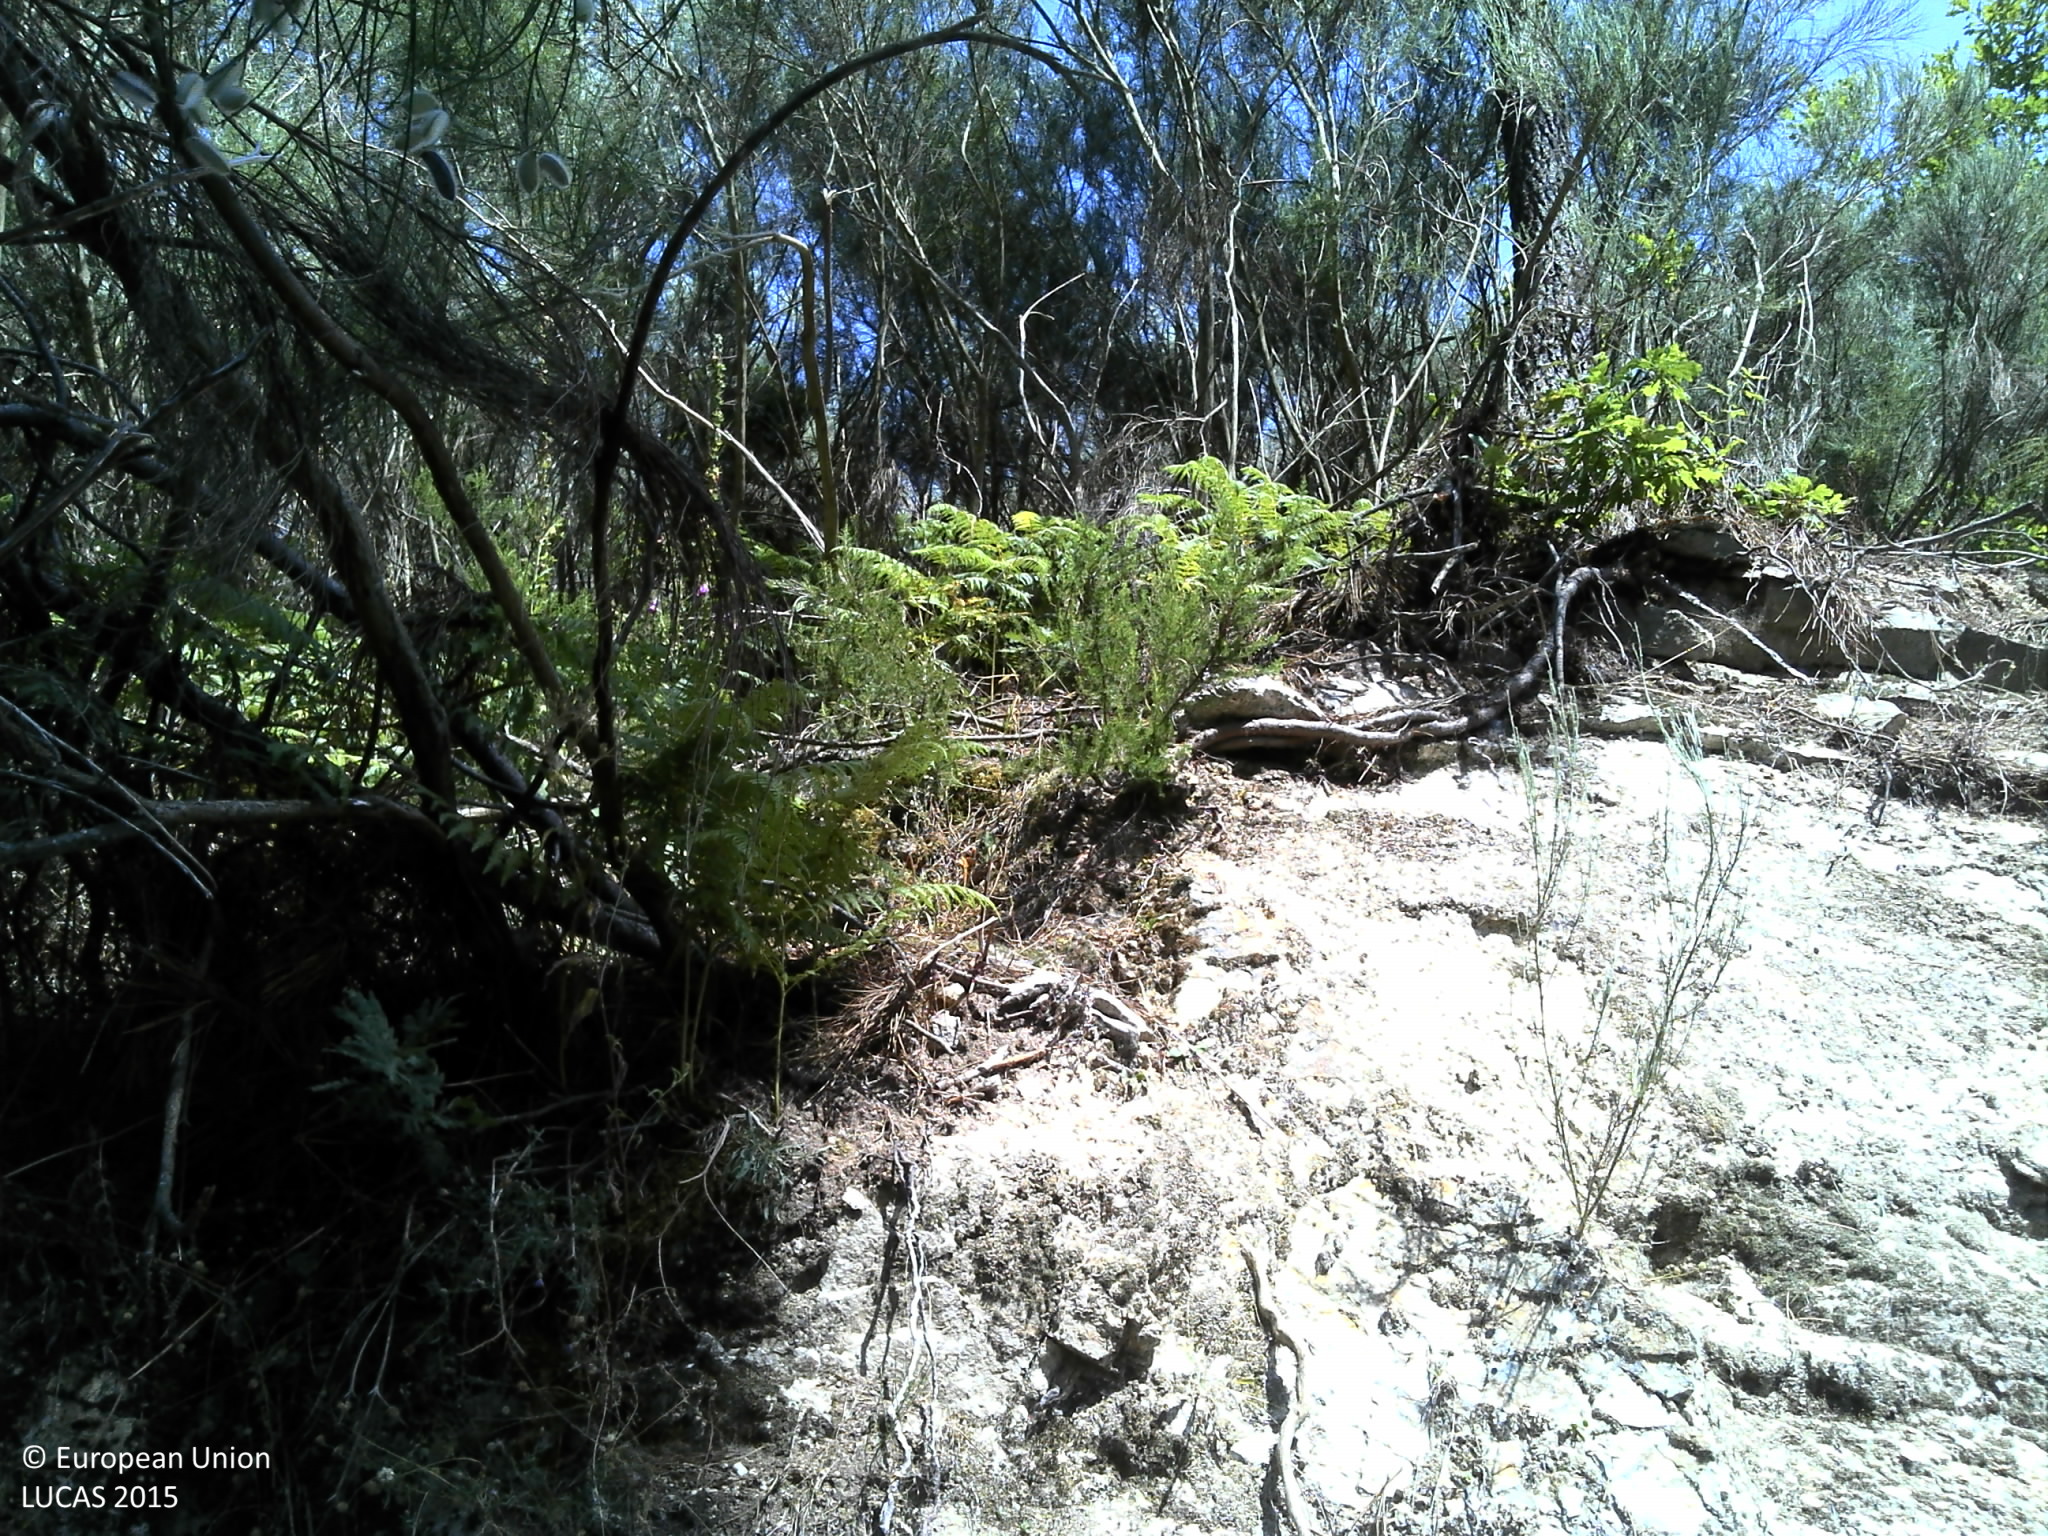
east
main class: Shrubland
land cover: Shrubland with sparse tree cover
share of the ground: > 75 %
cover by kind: shrubs 70 %, unconsolidated bare surface 25 %, coniferous forest trees 5 %
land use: Semi-natural and natural areas not in use
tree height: > 5 m
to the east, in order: Shrubland with sparse tree cover; Shrubland without tree cover; Nuts trees; Dry stone walls; Tracks; Dry stone walls; Shrubland without tree cover; Spontaneously vegetated surfaces; Electric lines; Spontaneously vegetated surfaces; Tracks; Shrubland without tree cover
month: July
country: PT
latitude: 40.9579
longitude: -7.8664
